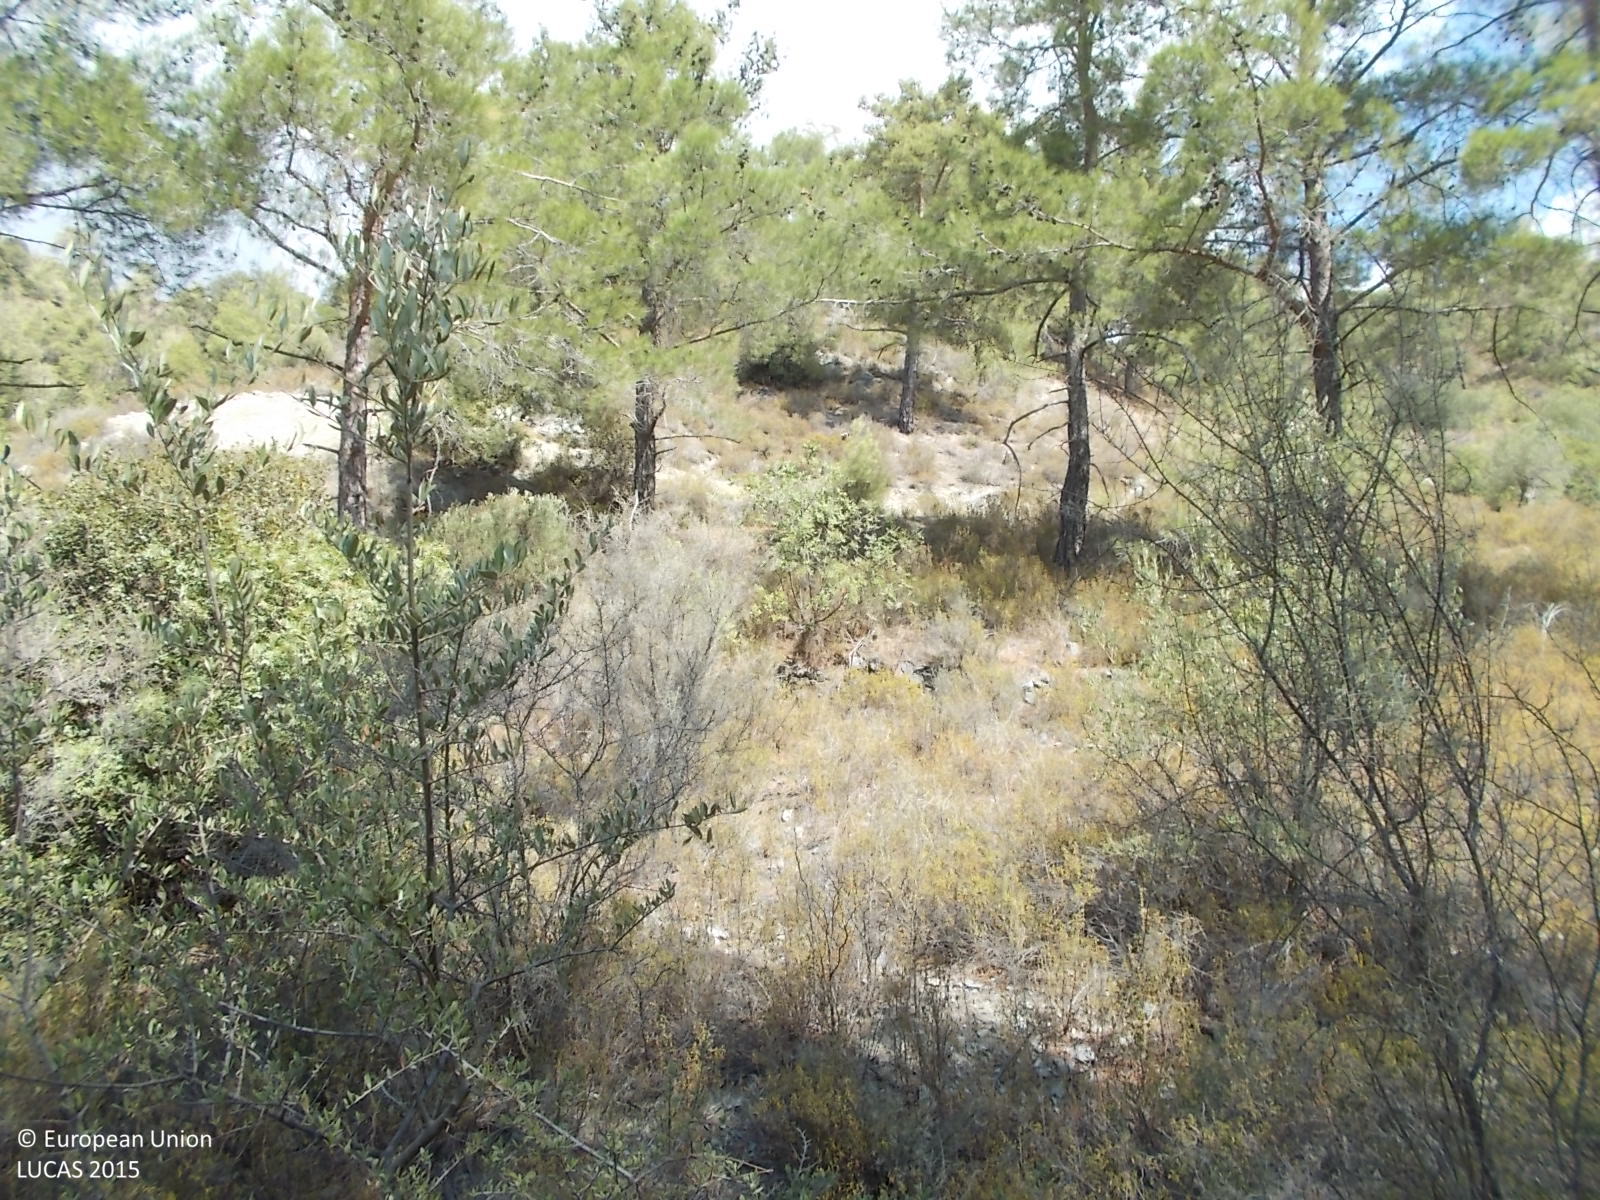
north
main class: Woodland
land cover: Pine dominated mixed woodland
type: coniferous forest of the mediterranean region
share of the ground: 50 - 75 %
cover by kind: coniferous forest trees 45 %, shrubs 25 %, broadleaved forest trees 15 %, unconsolidated bare surface 15 %
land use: Semi-natural and natural areas not in use
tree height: > 5 m
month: September
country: CY
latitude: 34.8648
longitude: 33.0896
